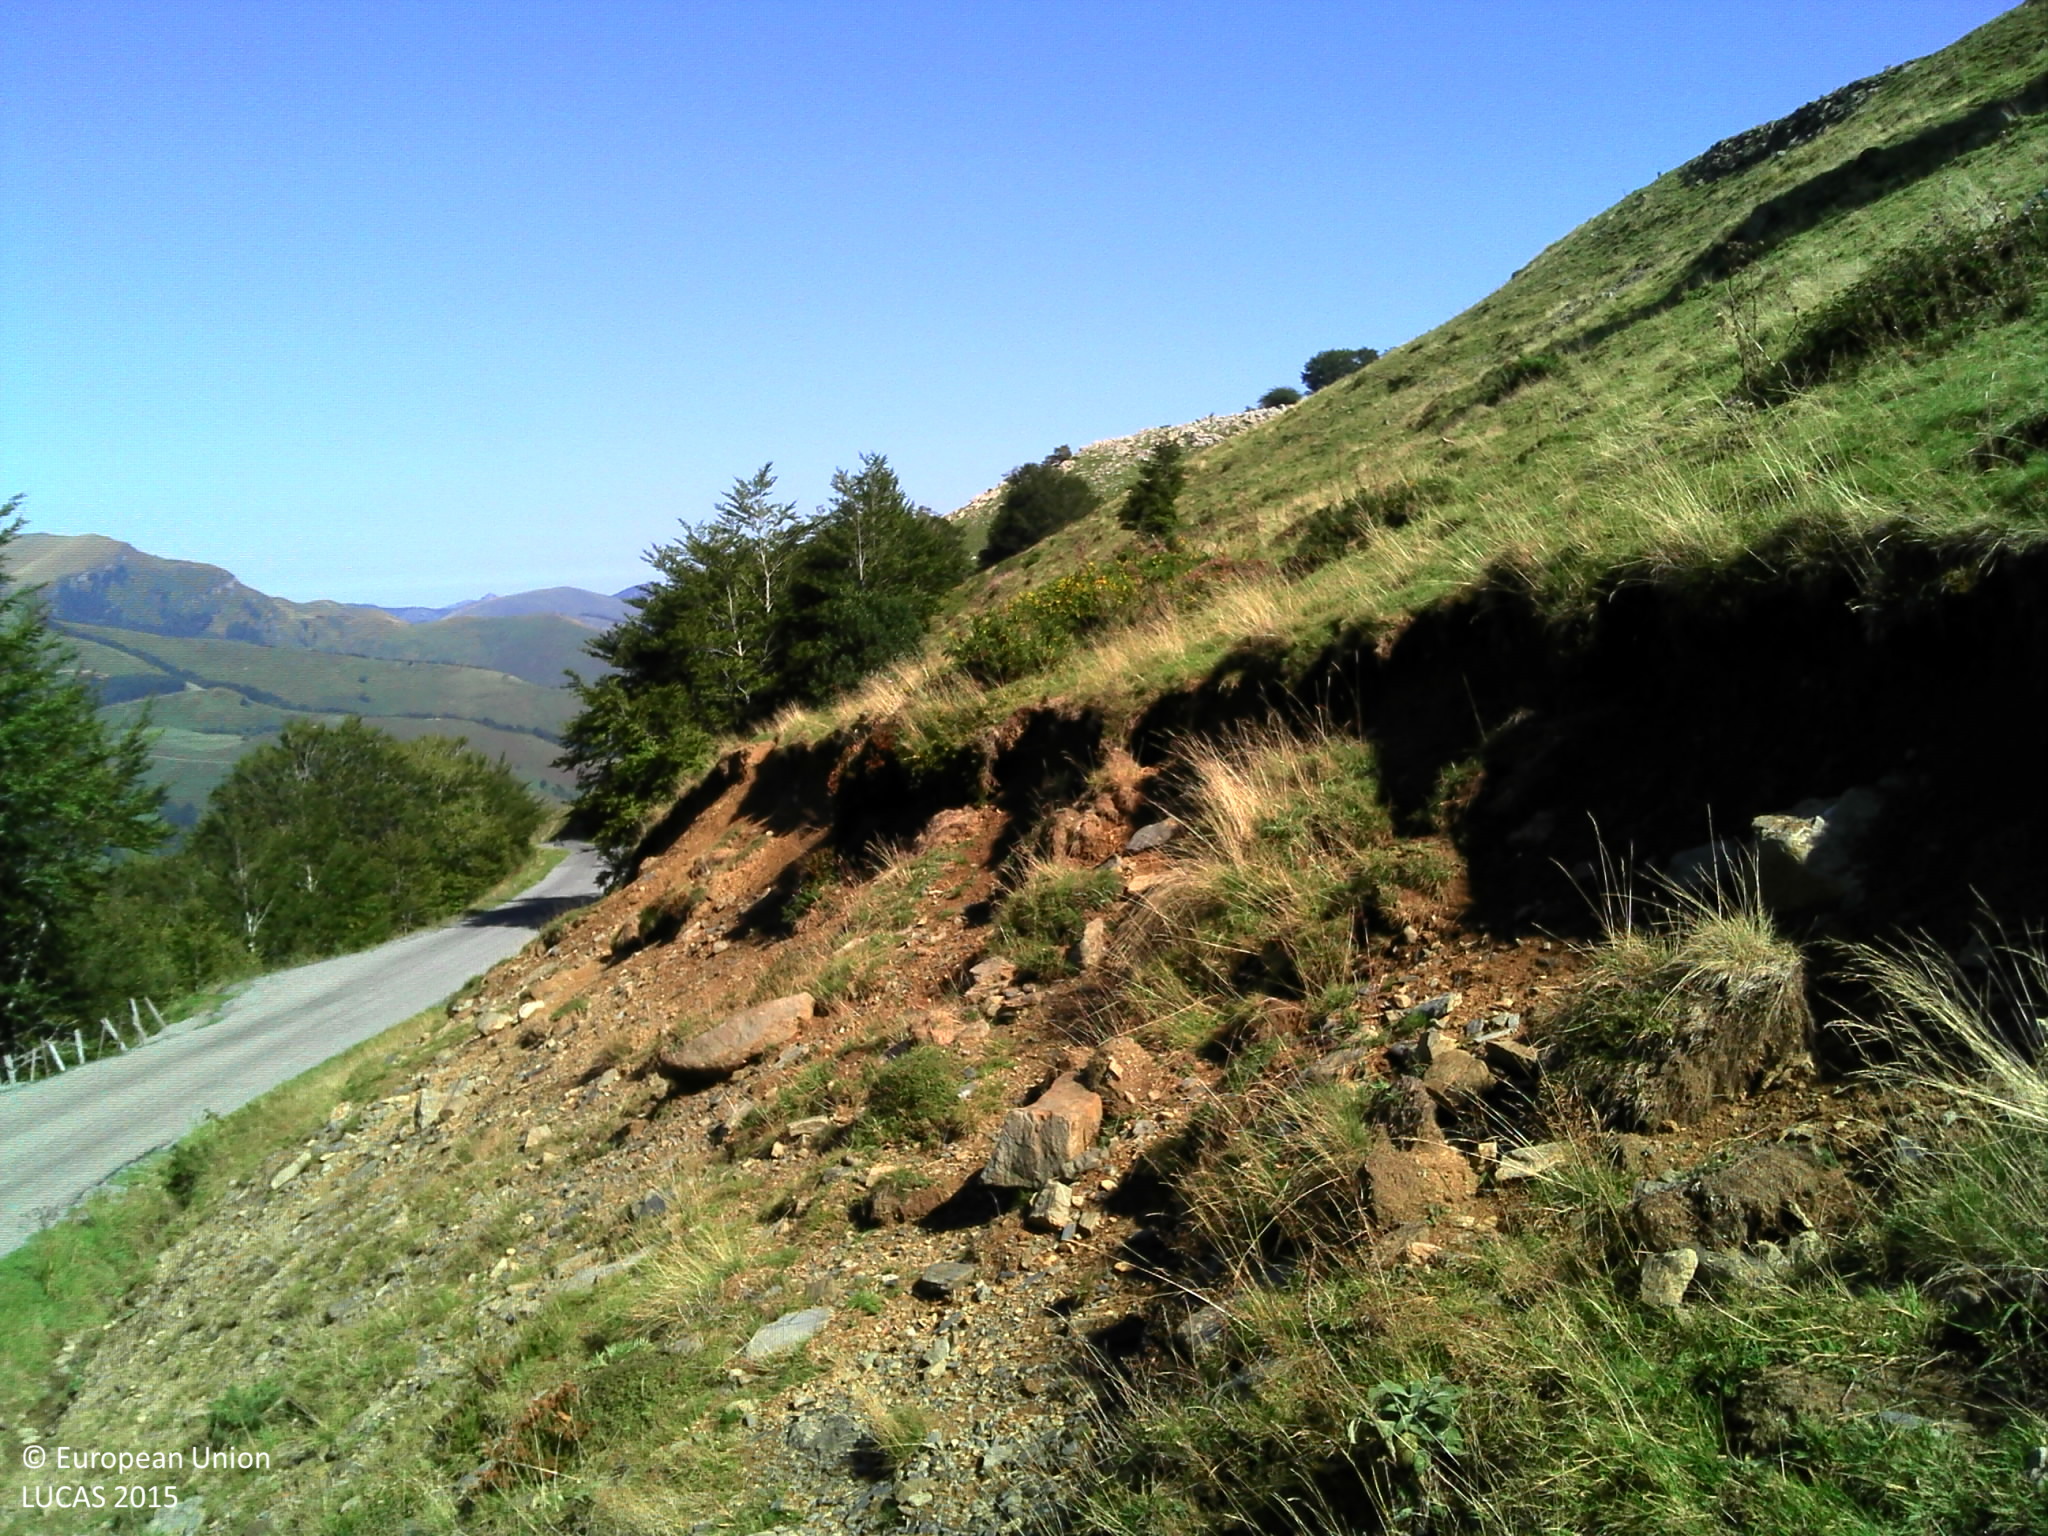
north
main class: Grassland
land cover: Spontaneously vegetated surfaces
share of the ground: 50 - 75 %
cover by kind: herbaceous plants 55 %, unconsolidated bare surface 30 %, consolidated bare surface 10 %, shrubs 5 %
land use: Agriculture (excluding fallow land and kitchen gardens)
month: September
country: FR
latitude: 43.0010
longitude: -0.9887
